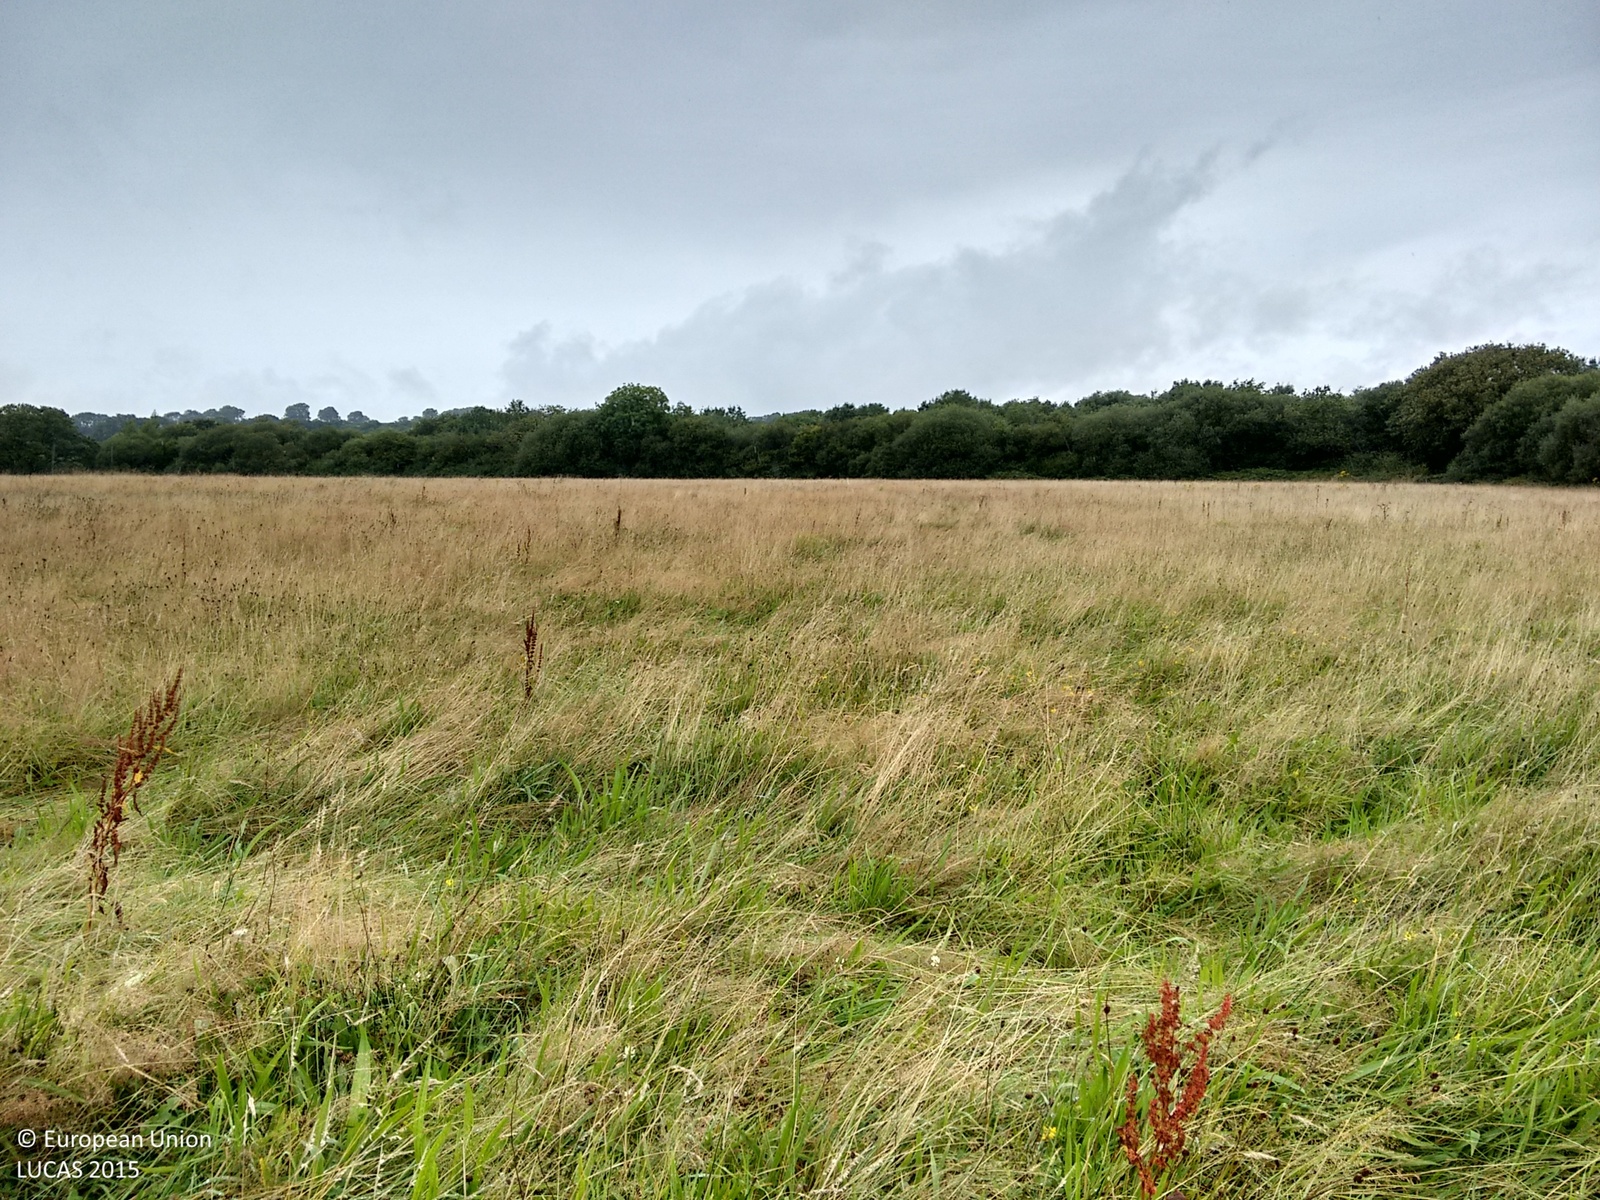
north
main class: Grassland
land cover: Grassland without tree/shrub cover
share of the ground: > 75 %
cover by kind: herbaceous plants 100 %
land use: Agriculture (excluding fallow land and kitchen gardens)
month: August
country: GB
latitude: 51.8218
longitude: -4.8391
